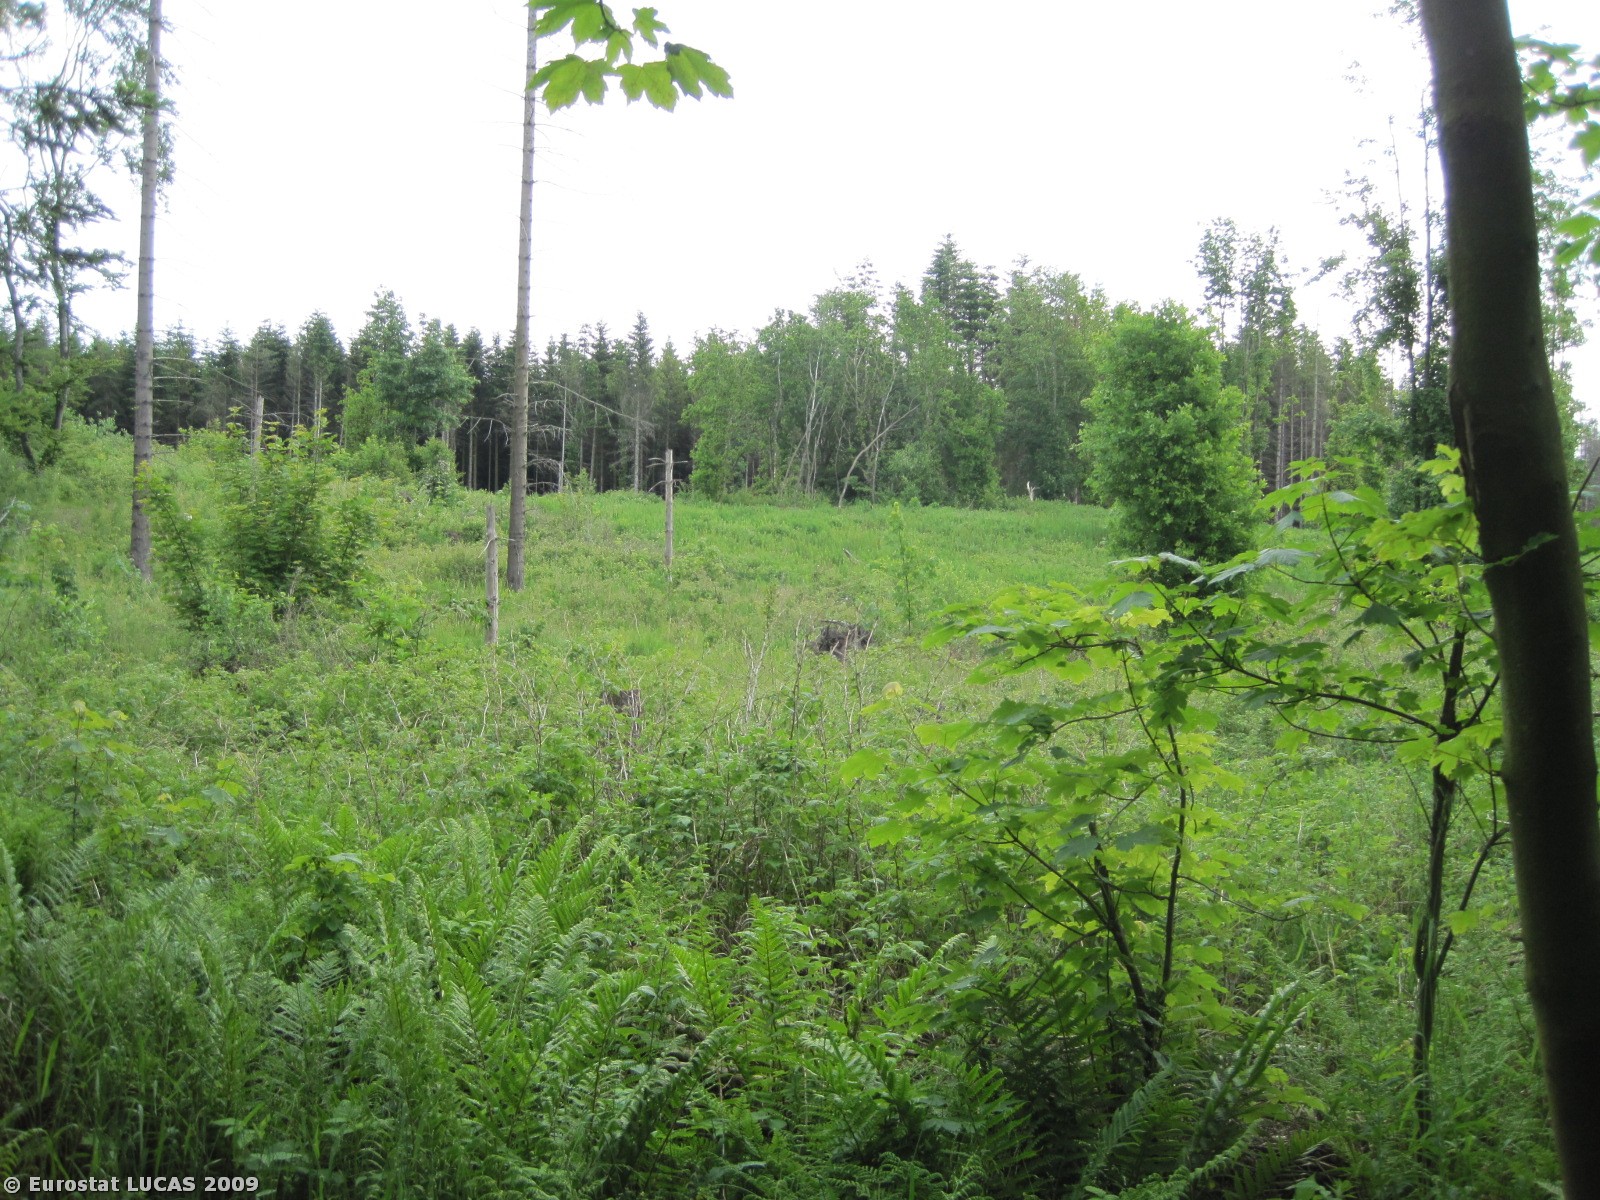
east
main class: Woodland
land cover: Mixed woodland
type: plantations and self-sown exotic forest
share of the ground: 50 - 75 %
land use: Agriculture (excluding fallow land and kitchen gardens)
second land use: Amenities, museums, leisure
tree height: > 5 m
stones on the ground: < 10 %
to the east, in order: Mixed woodland; Shrubland with sparse tree cover; Tracks; Grassland with sparse tree/shrub cover; Single bushes/trees; Grassland with sparse tree/shrub cover; Coniferous woodland; Grass margins; Paved roads, cycling and walking lanes; Grass margins; Mixed woodland; Grassland without tree/shrub cover; Broadleaved woodland
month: June
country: DK
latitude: 57.0865
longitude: 10.1483
